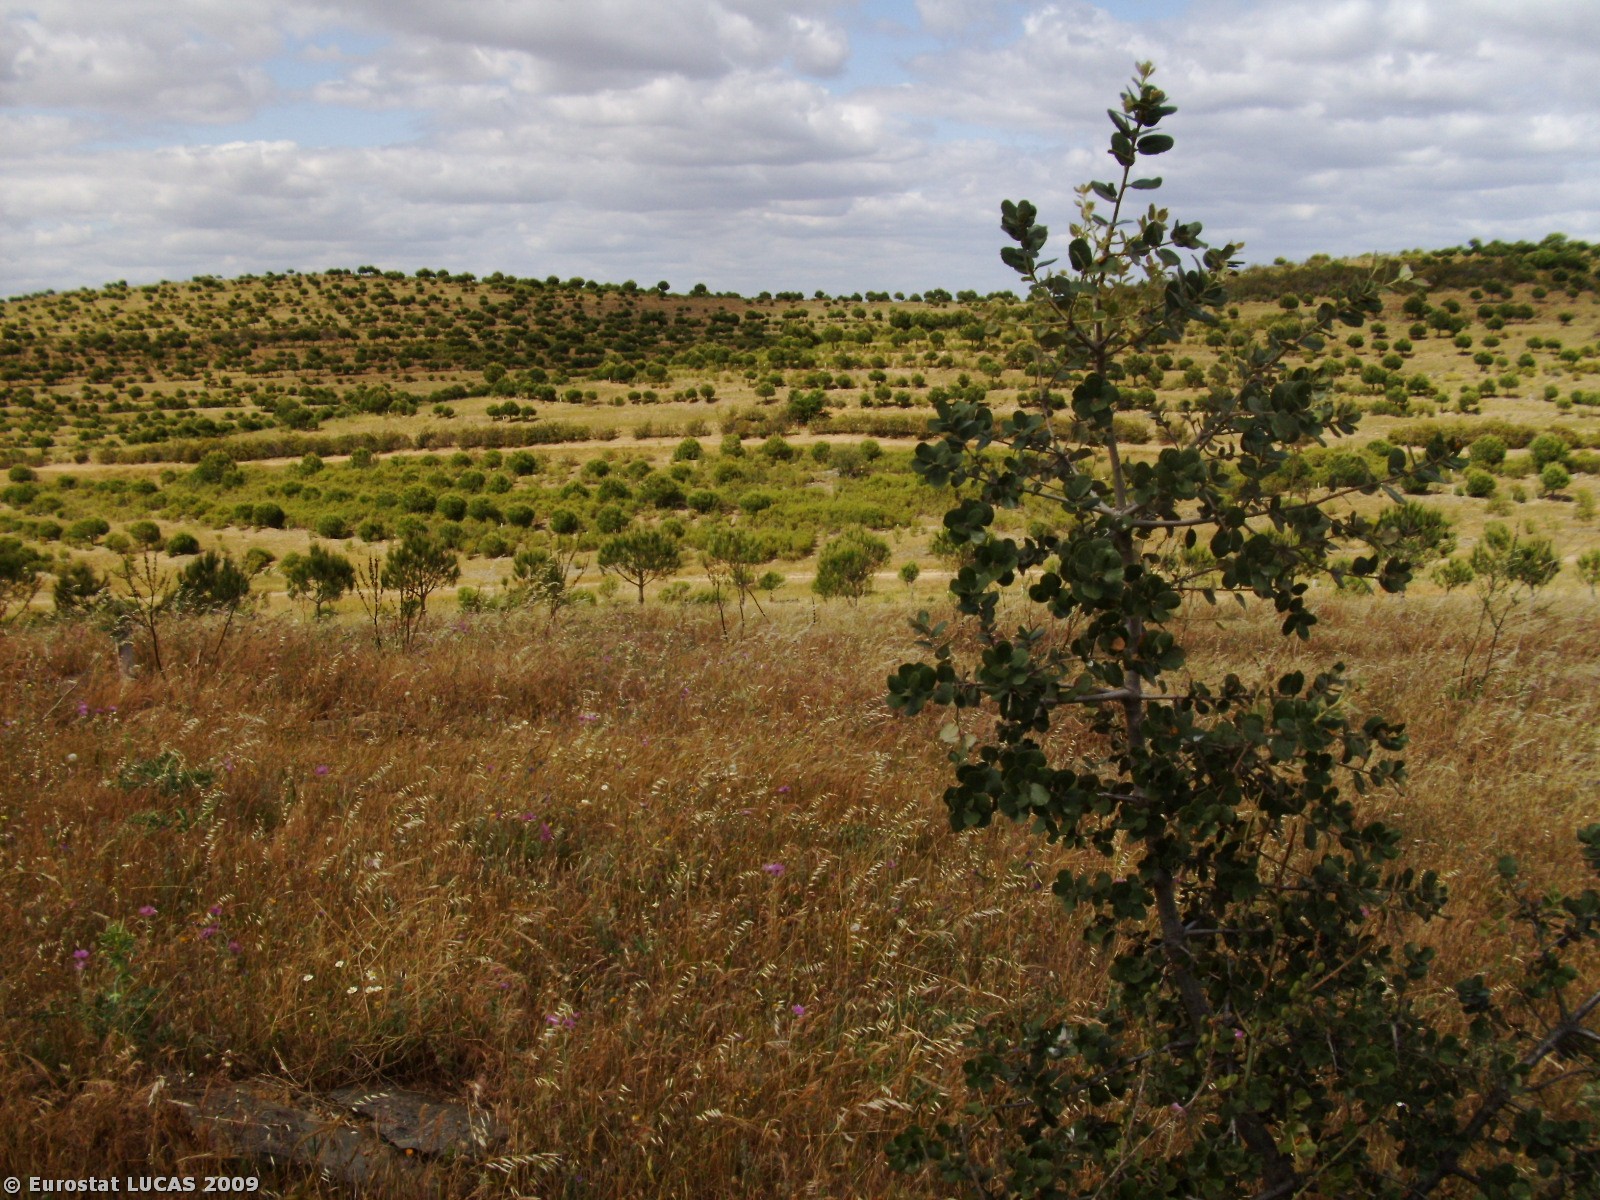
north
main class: Woodland
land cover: Coniferous woodland
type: coniferous forest of the mediterranean region
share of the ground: 25 - 50 %
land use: Forestry
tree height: > 5 m
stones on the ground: < 10 %
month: April
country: PT
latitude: 37.5517
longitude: -7.7069
